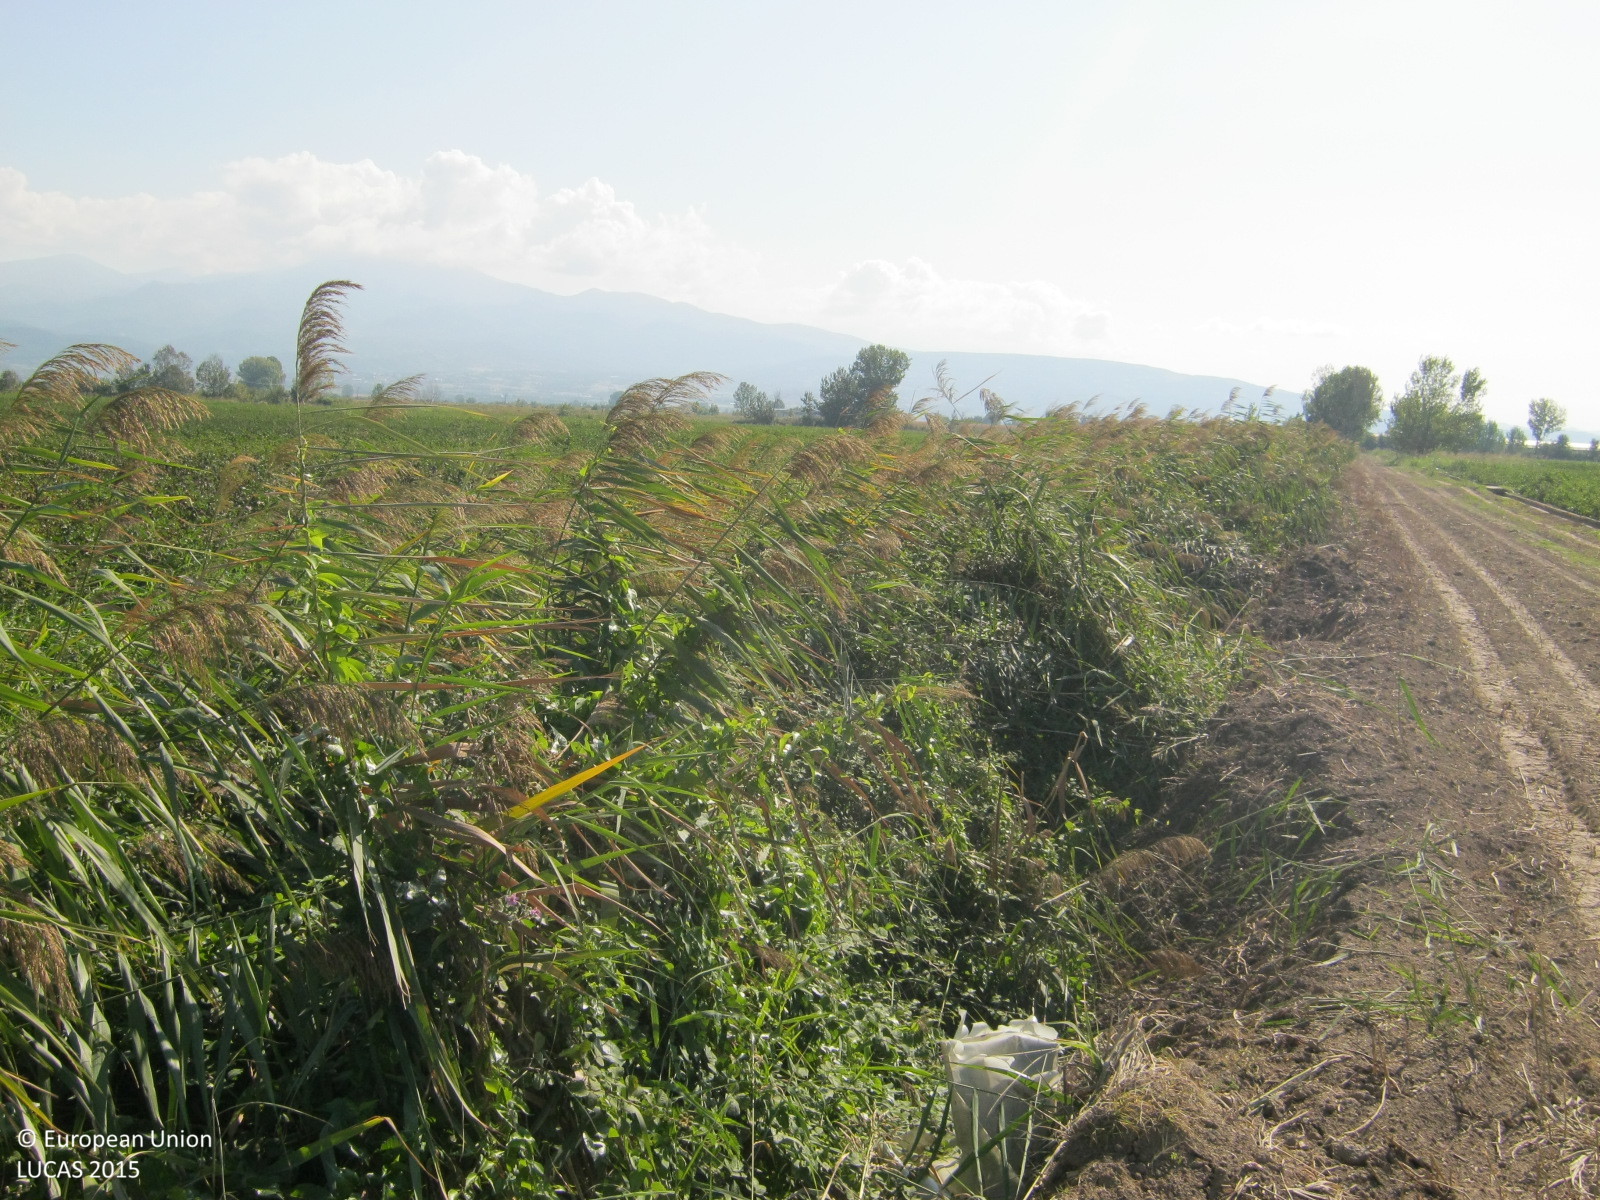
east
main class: Cropland
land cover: Cotton
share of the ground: > 75 %
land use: Agriculture (excluding fallow land and kitchen gardens)
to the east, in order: Cotton; Clovers; Cotton
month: September
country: GR
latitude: 41.2037
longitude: 23.3150
